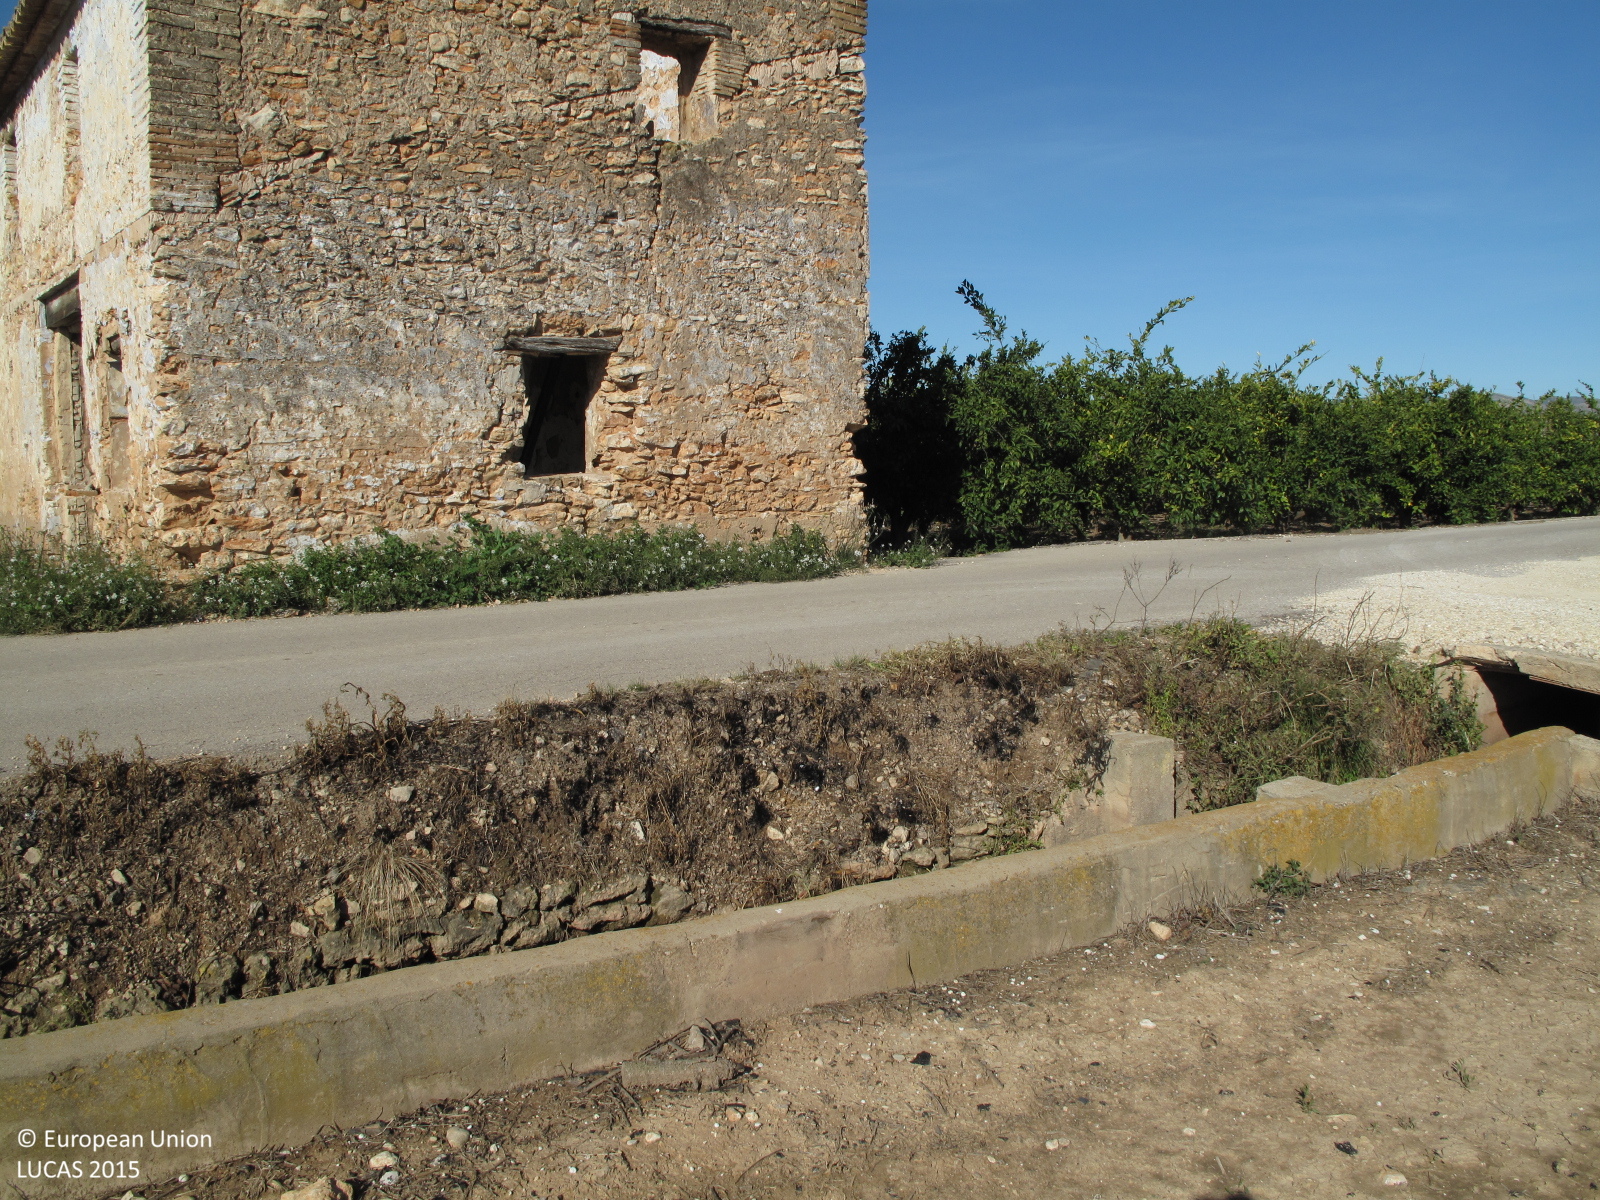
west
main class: Cropland
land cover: Other fruit trees and berries
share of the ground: 25 - 50 %
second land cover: Spontaneously vegetated surfaces
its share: 10 - 25 %
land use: Agriculture (excluding fallow land and kitchen gardens)
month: March
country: ES
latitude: 39.1512
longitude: -0.5361
